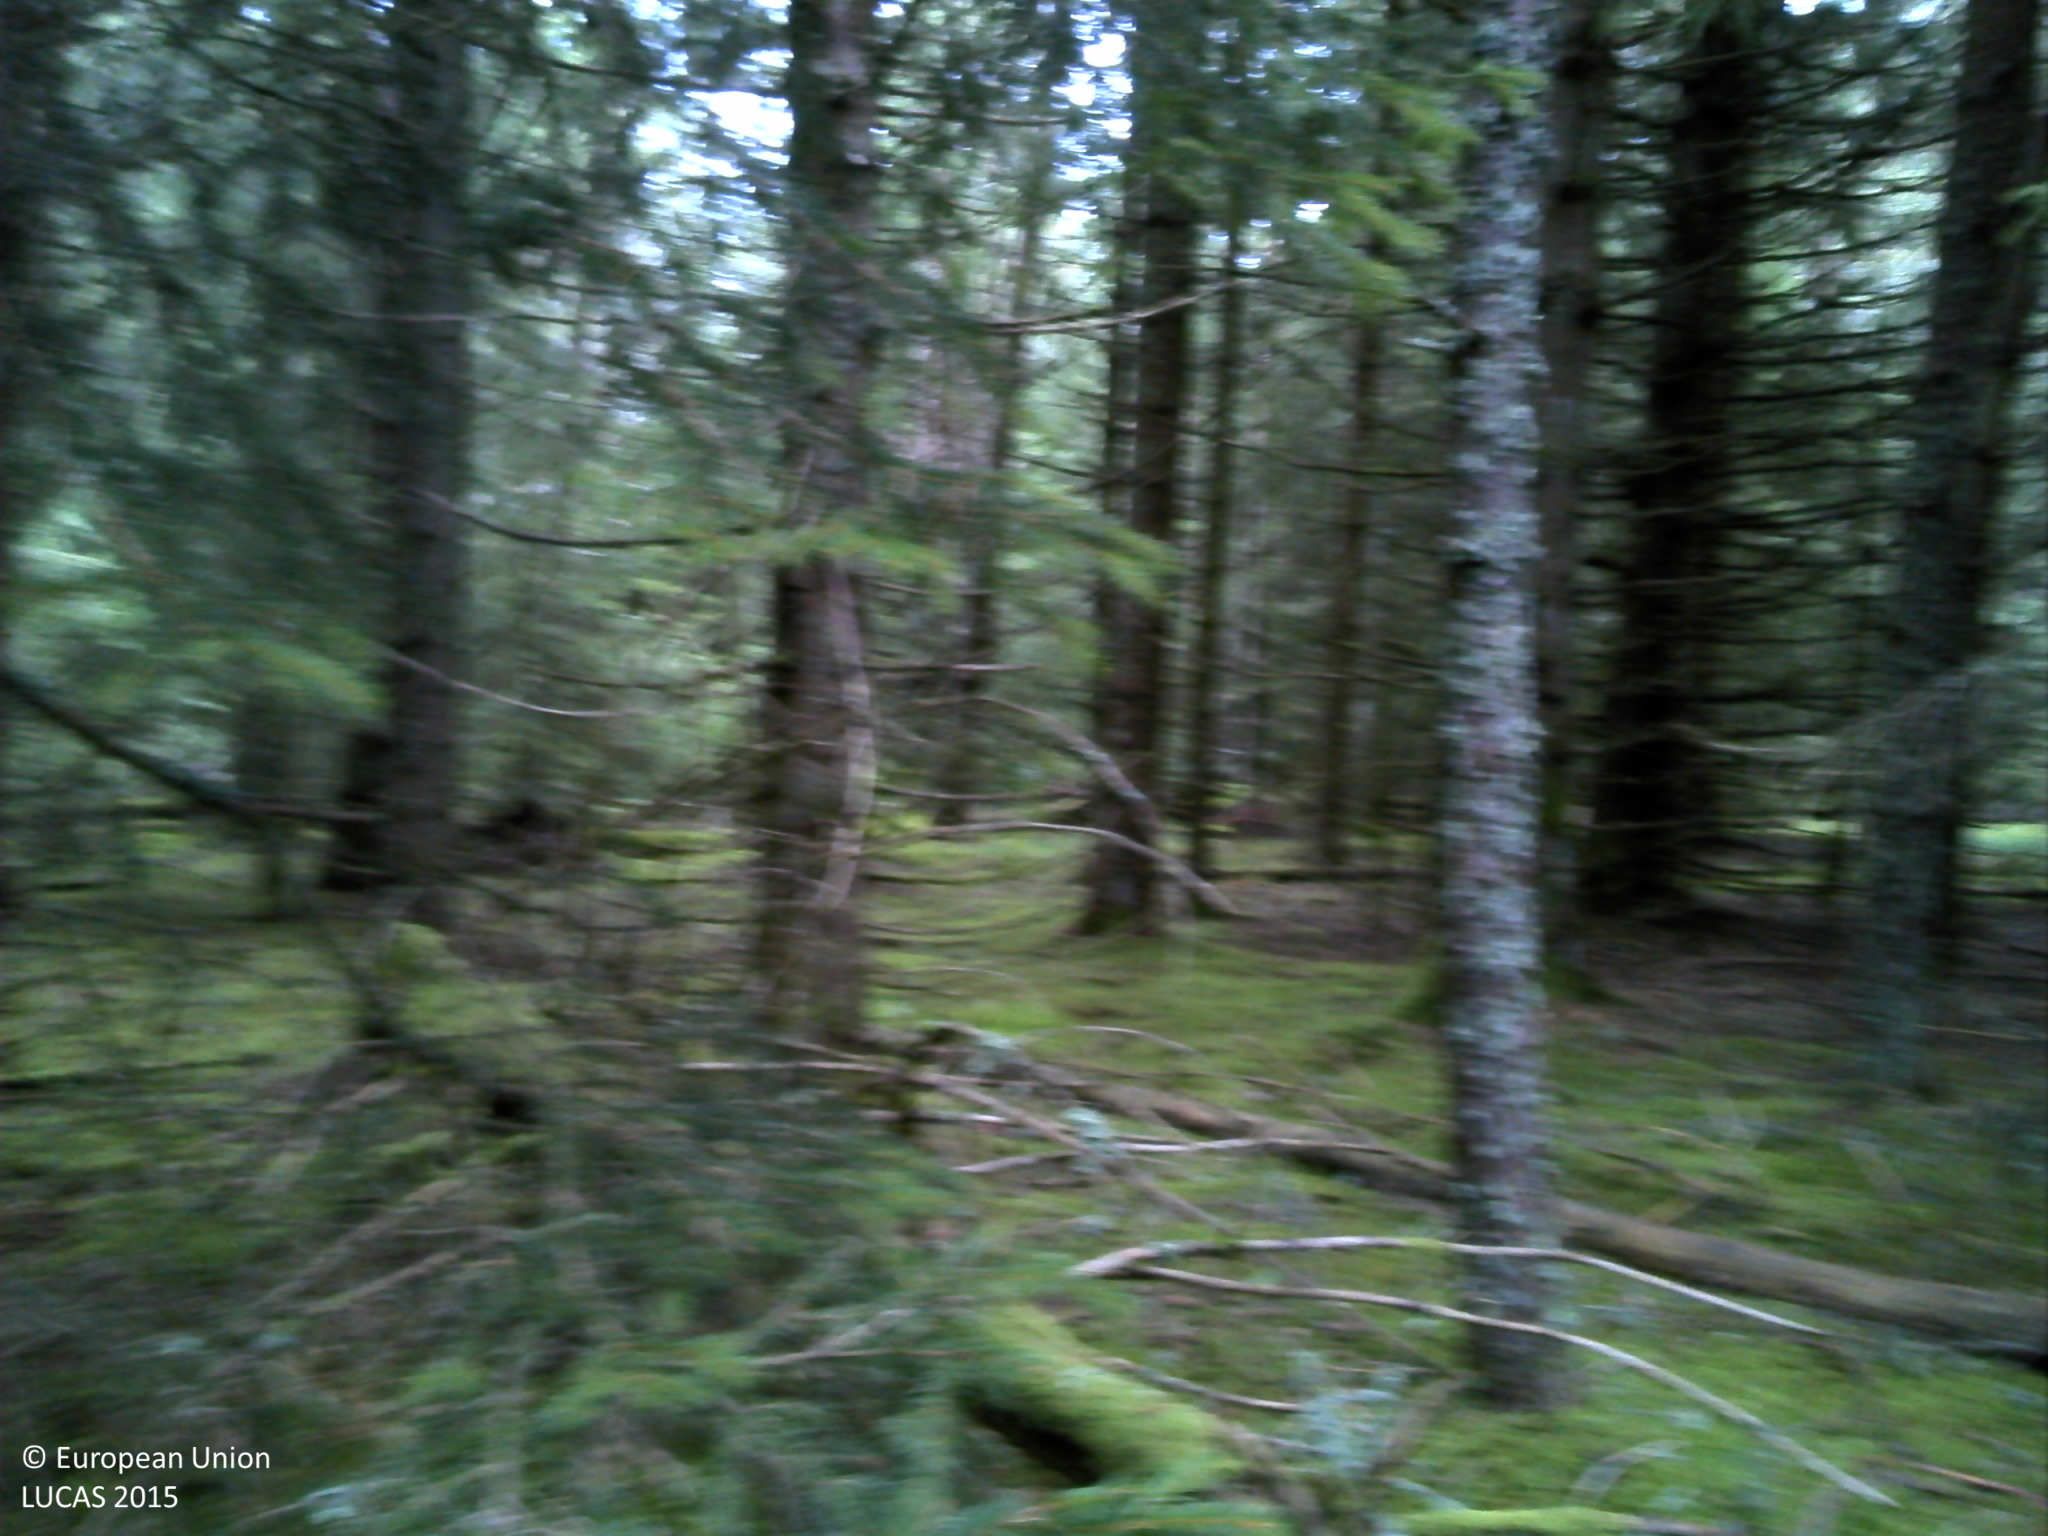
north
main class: Woodland
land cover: Spruce dominated coniferous woodland
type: alpine coniferous forest
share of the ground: > 75 %
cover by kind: coniferous forest trees 75 %, lichens and mosses 25 %
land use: Forestry
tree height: > 5 m
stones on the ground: < 10 %
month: September
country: FR
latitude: 45.6436
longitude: 2.8786
